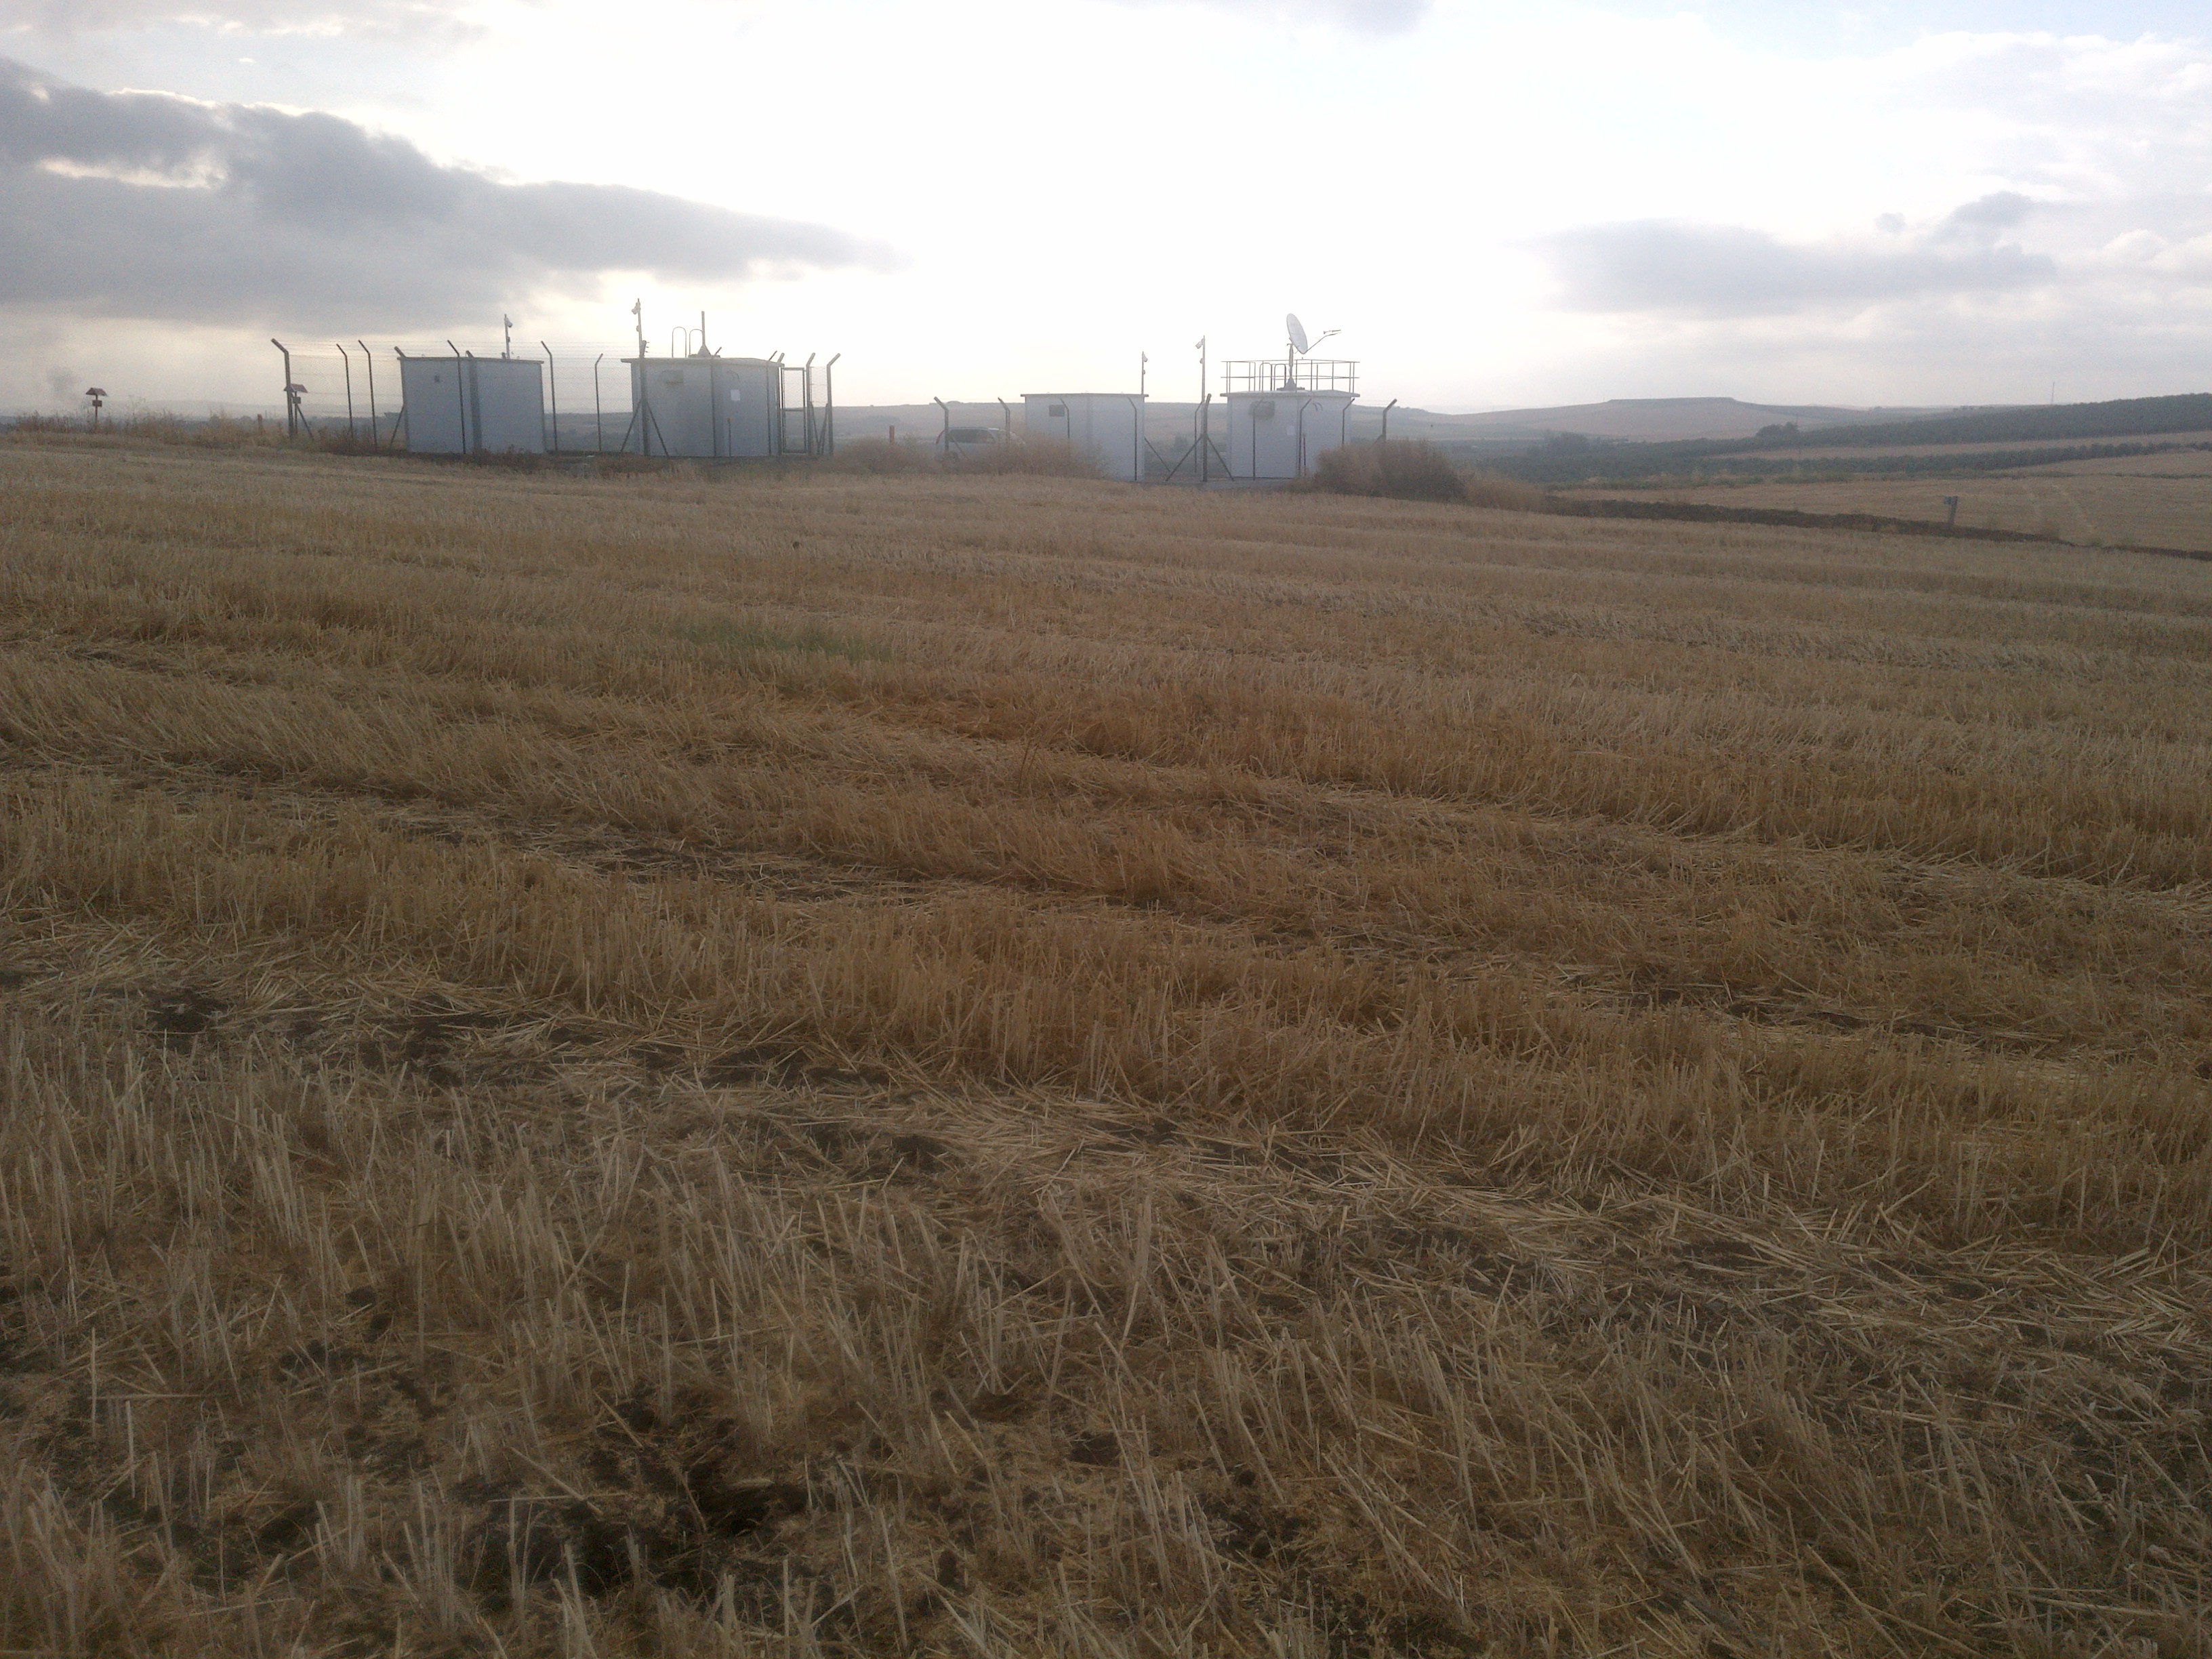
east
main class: Cropland
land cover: Sunflower
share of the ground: > 75 %
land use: Agriculture (excluding fallow land and kitchen gardens)
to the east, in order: Sunflower; Durum wheat; Tracks; Durum wheat; Grass margins; Durum wheat
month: June
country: ES
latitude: 37.9398
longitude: -4.5888
